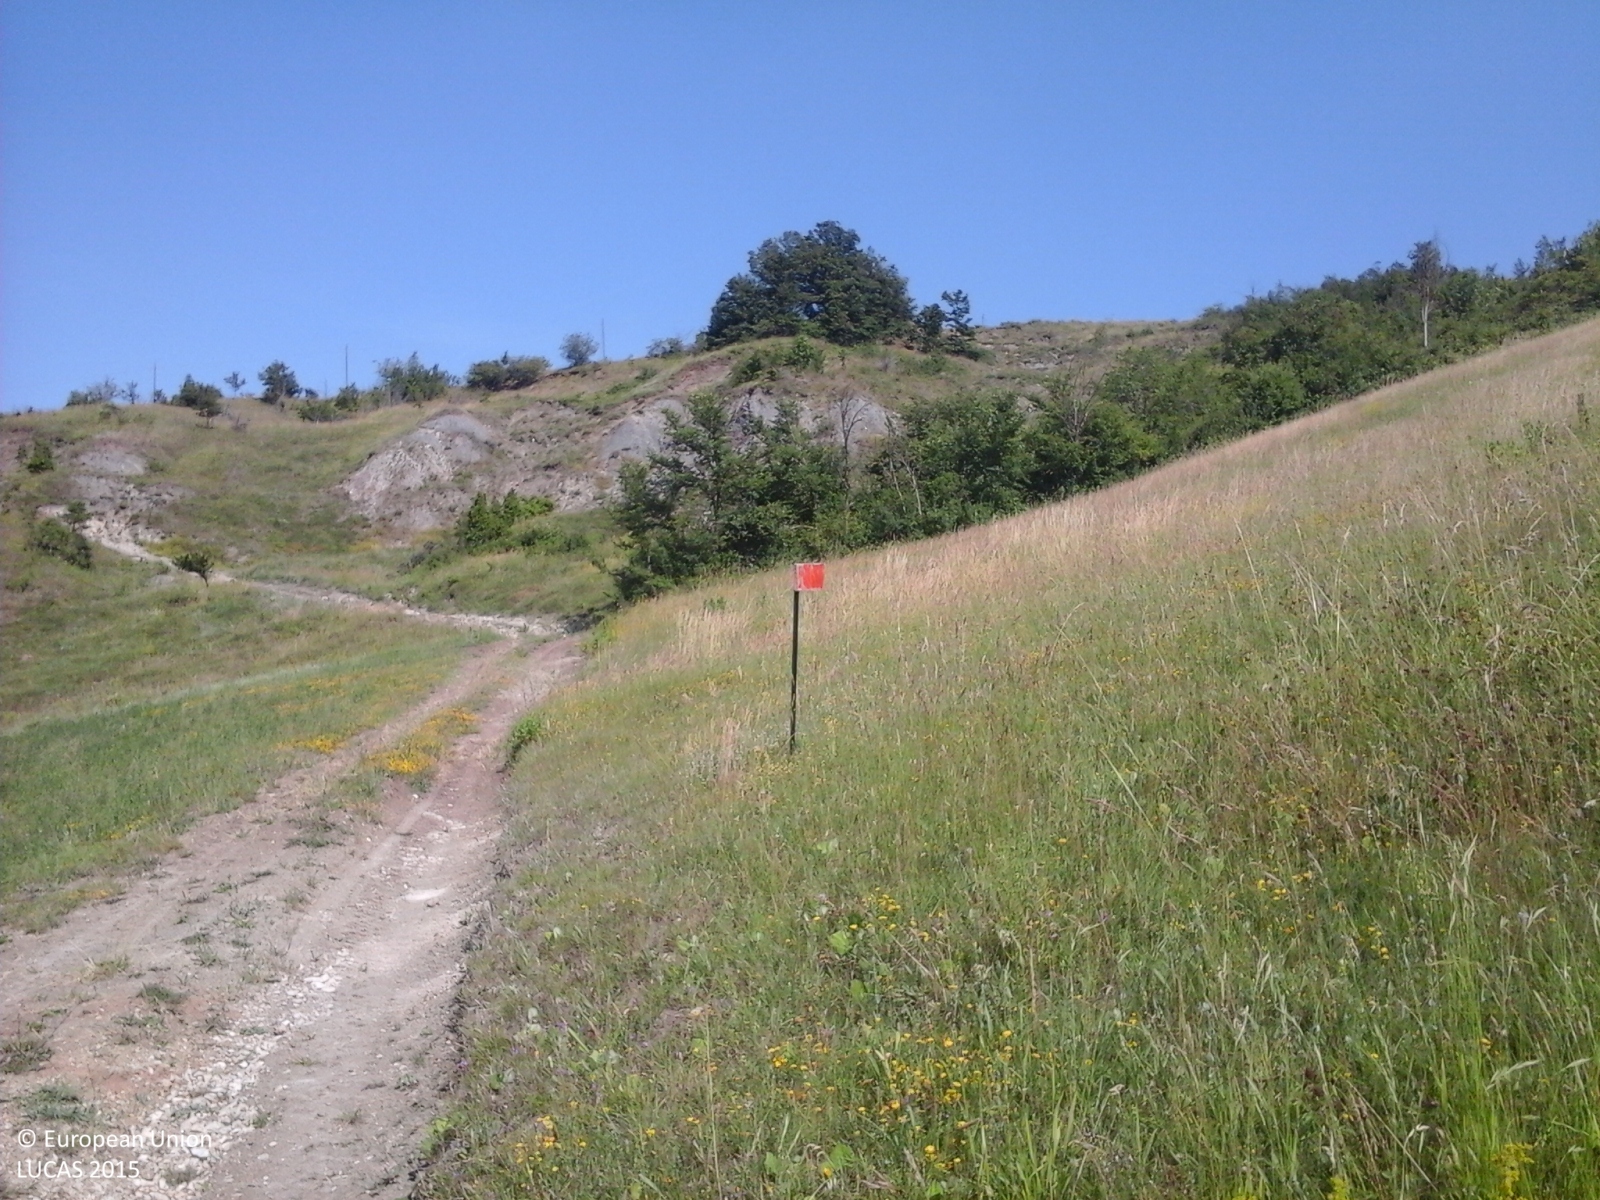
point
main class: Grassland
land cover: Grassland without tree/shrub cover
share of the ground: > 75 %
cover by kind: herbaceous plants 100 %
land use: Agriculture (excluding fallow land and kitchen gardens)
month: June
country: IT
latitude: 44.5484
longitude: 10.3391
